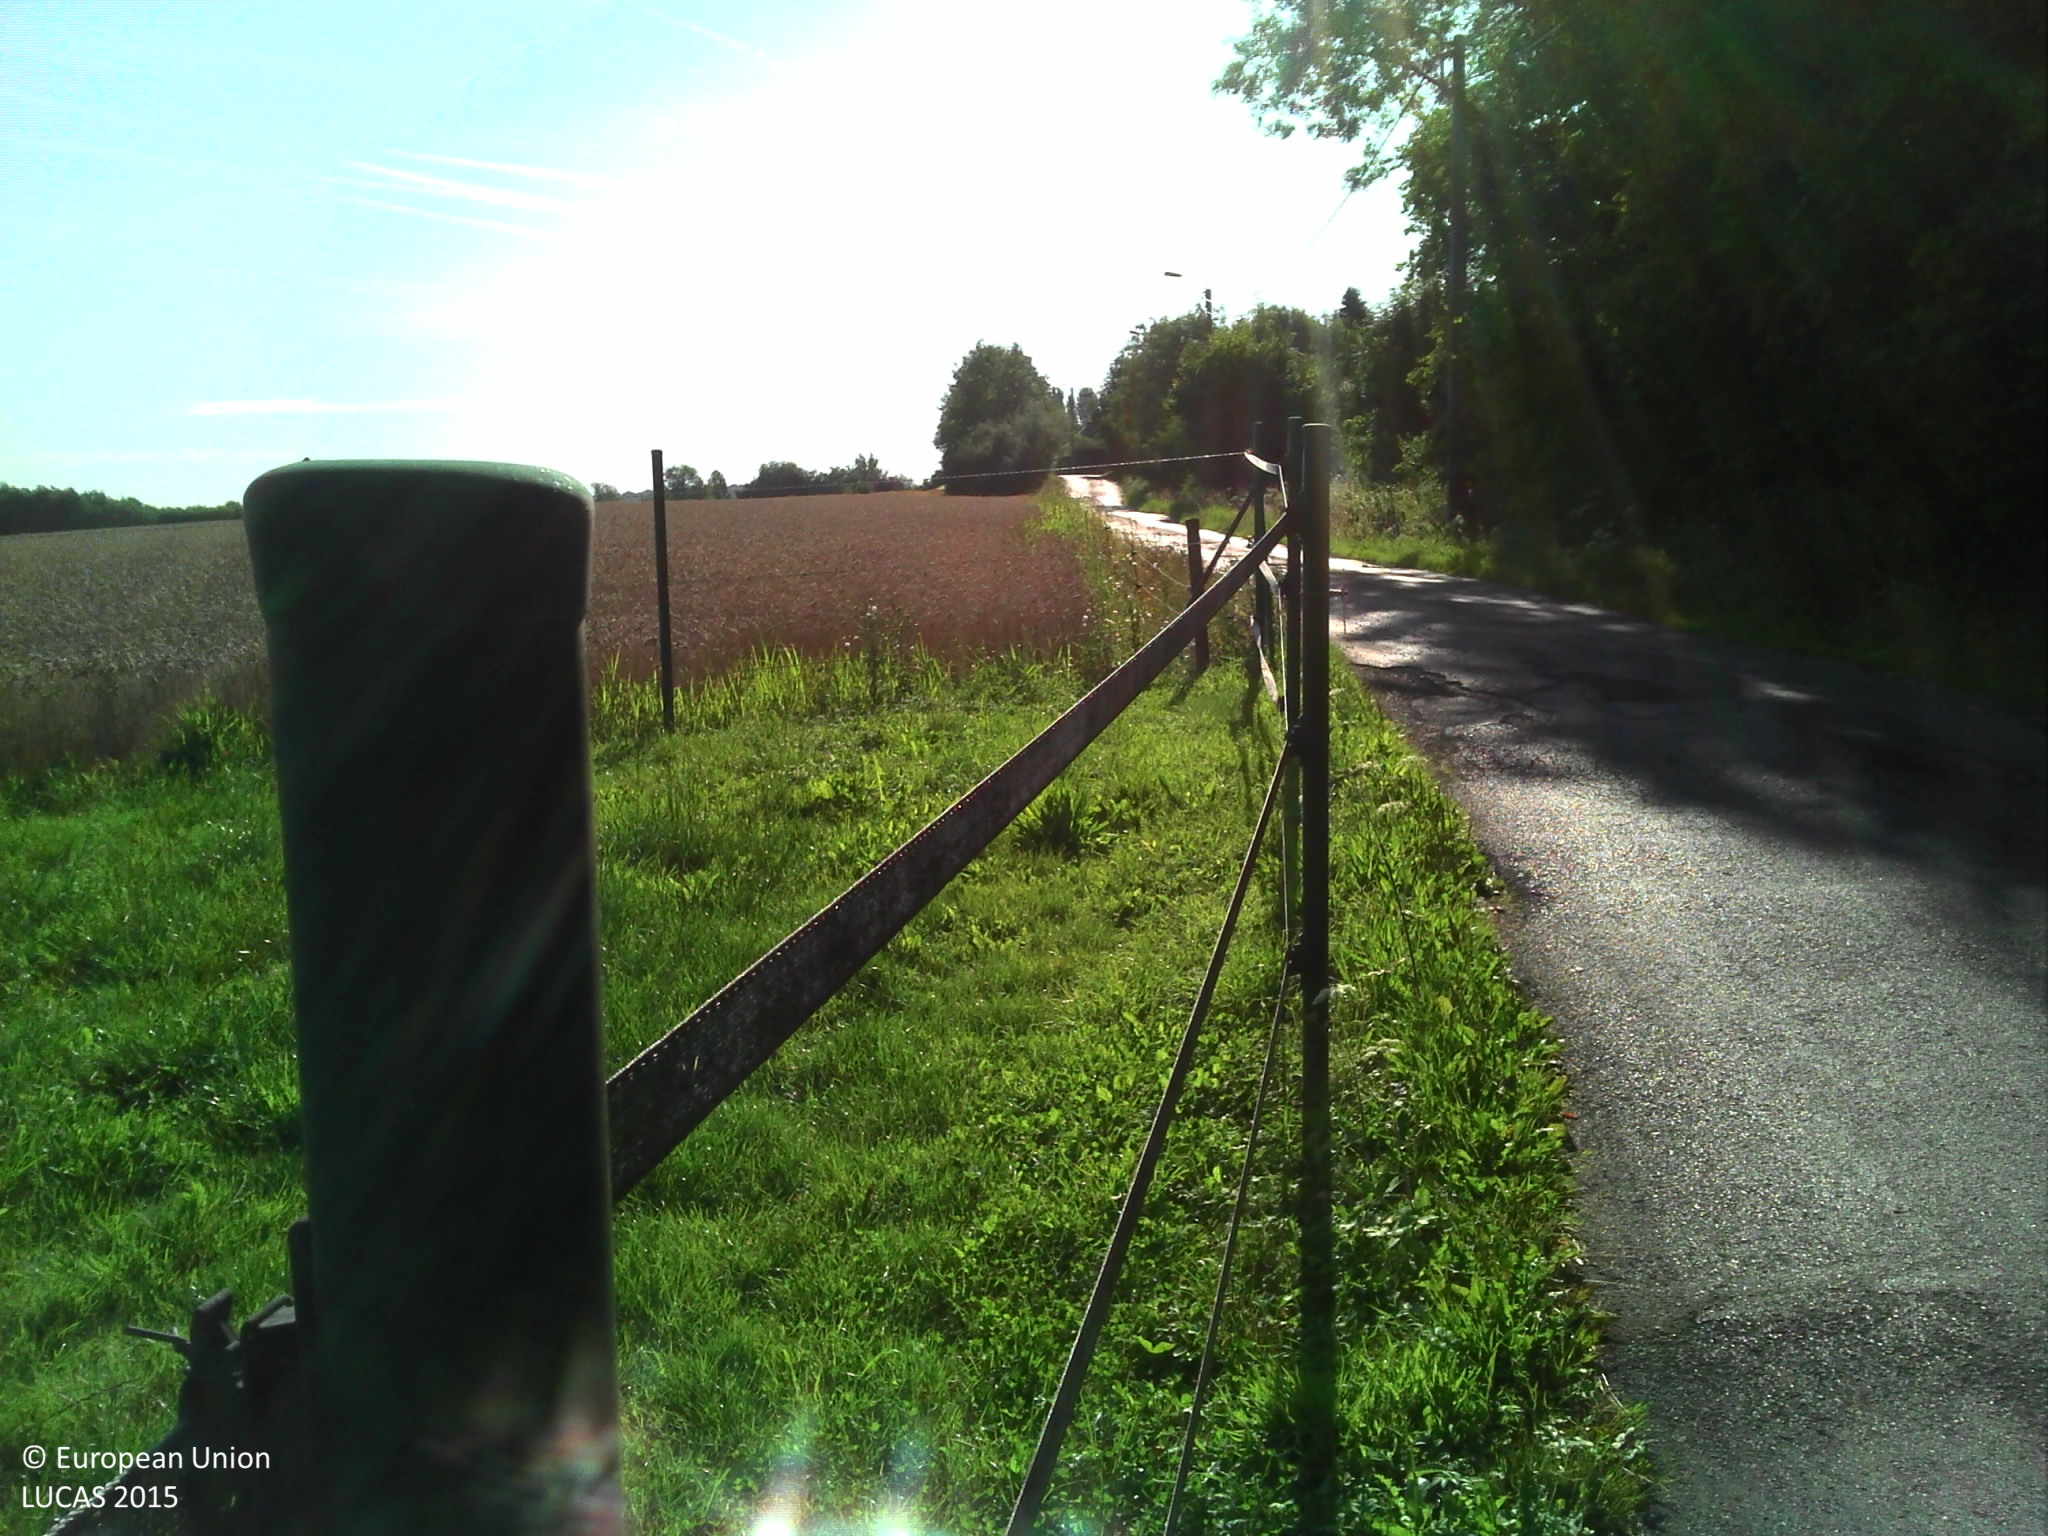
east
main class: Grassland
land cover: Grassland without tree/shrub cover
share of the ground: > 75 %
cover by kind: herbaceous plants 100 %
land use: Agriculture (excluding fallow land and kitchen gardens)
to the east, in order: Grassland without tree/shrub cover; Fences; Common wheat; Barley; Common wheat
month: August
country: BE
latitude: 50.4171
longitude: 4.6060
